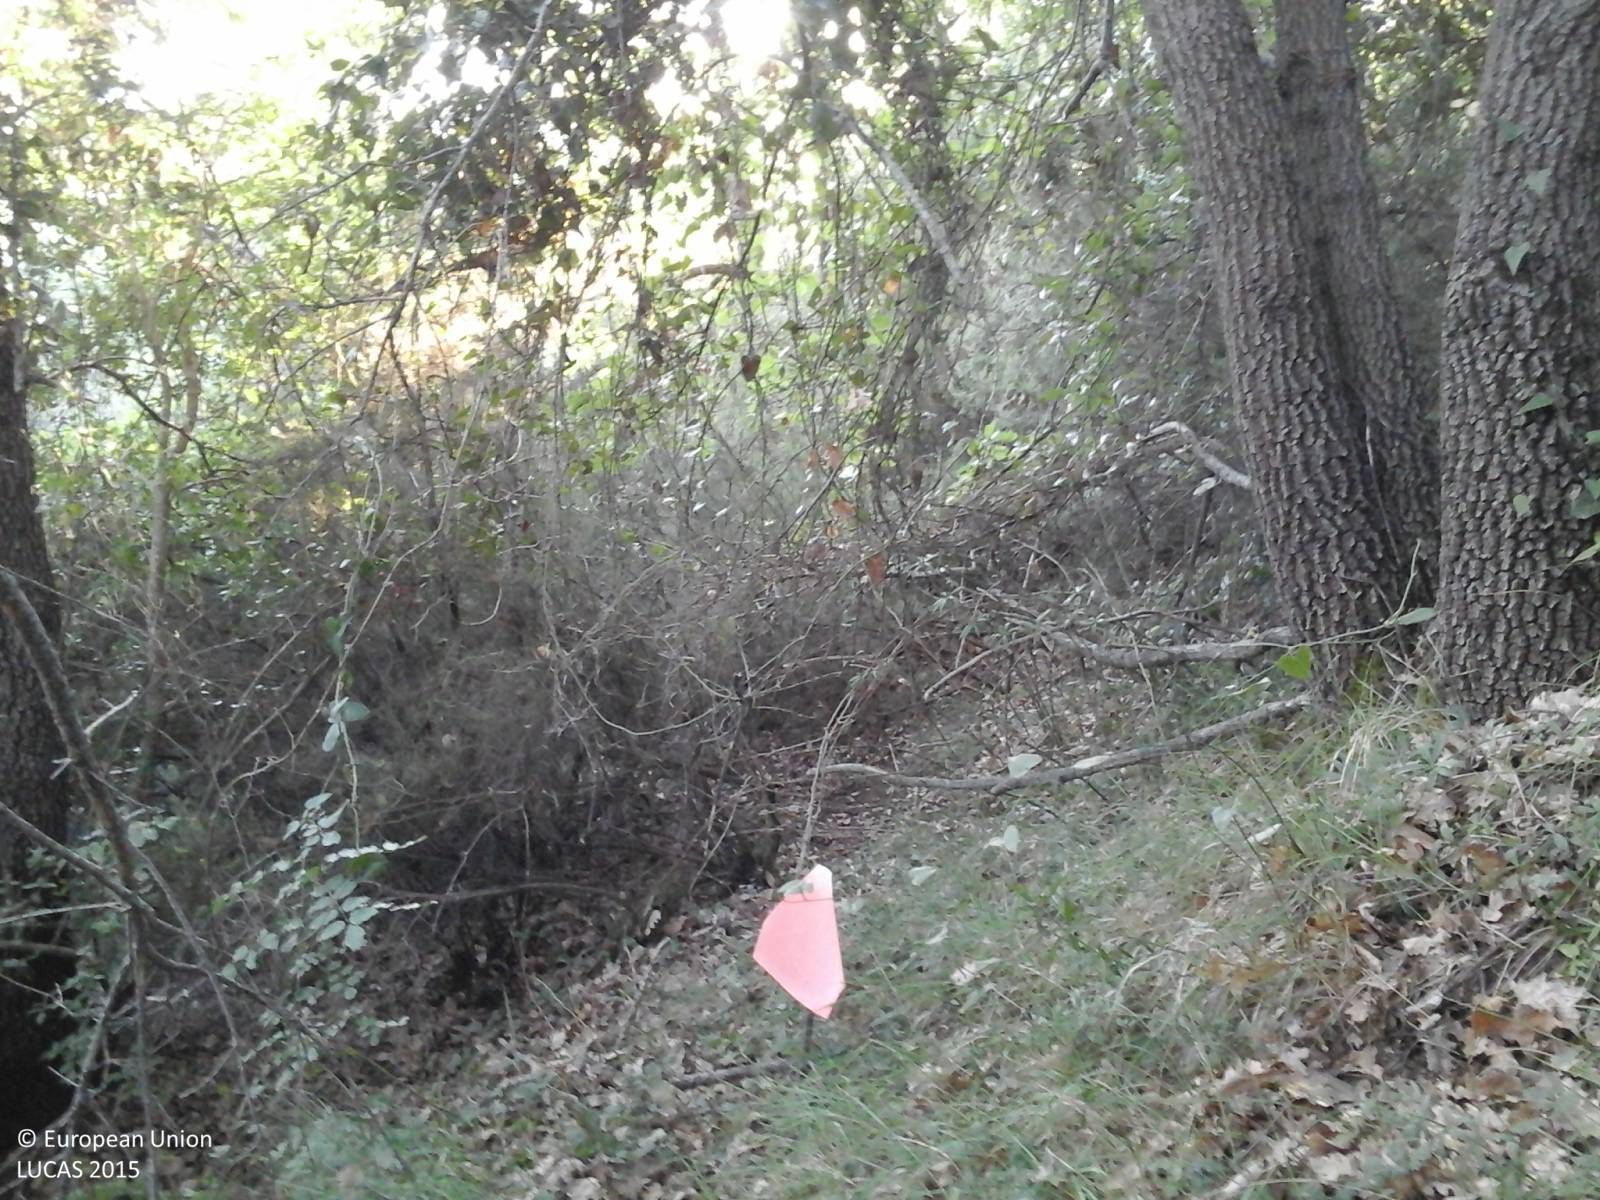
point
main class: Woodland
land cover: Broadleaved woodland
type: thermophilous deciduous forest
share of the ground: > 75 %
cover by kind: broadleaved forest trees 85 %, shrubs 15 %
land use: Forestry
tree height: > 5 m
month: September
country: IT
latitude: 42.8498
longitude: 12.0616
